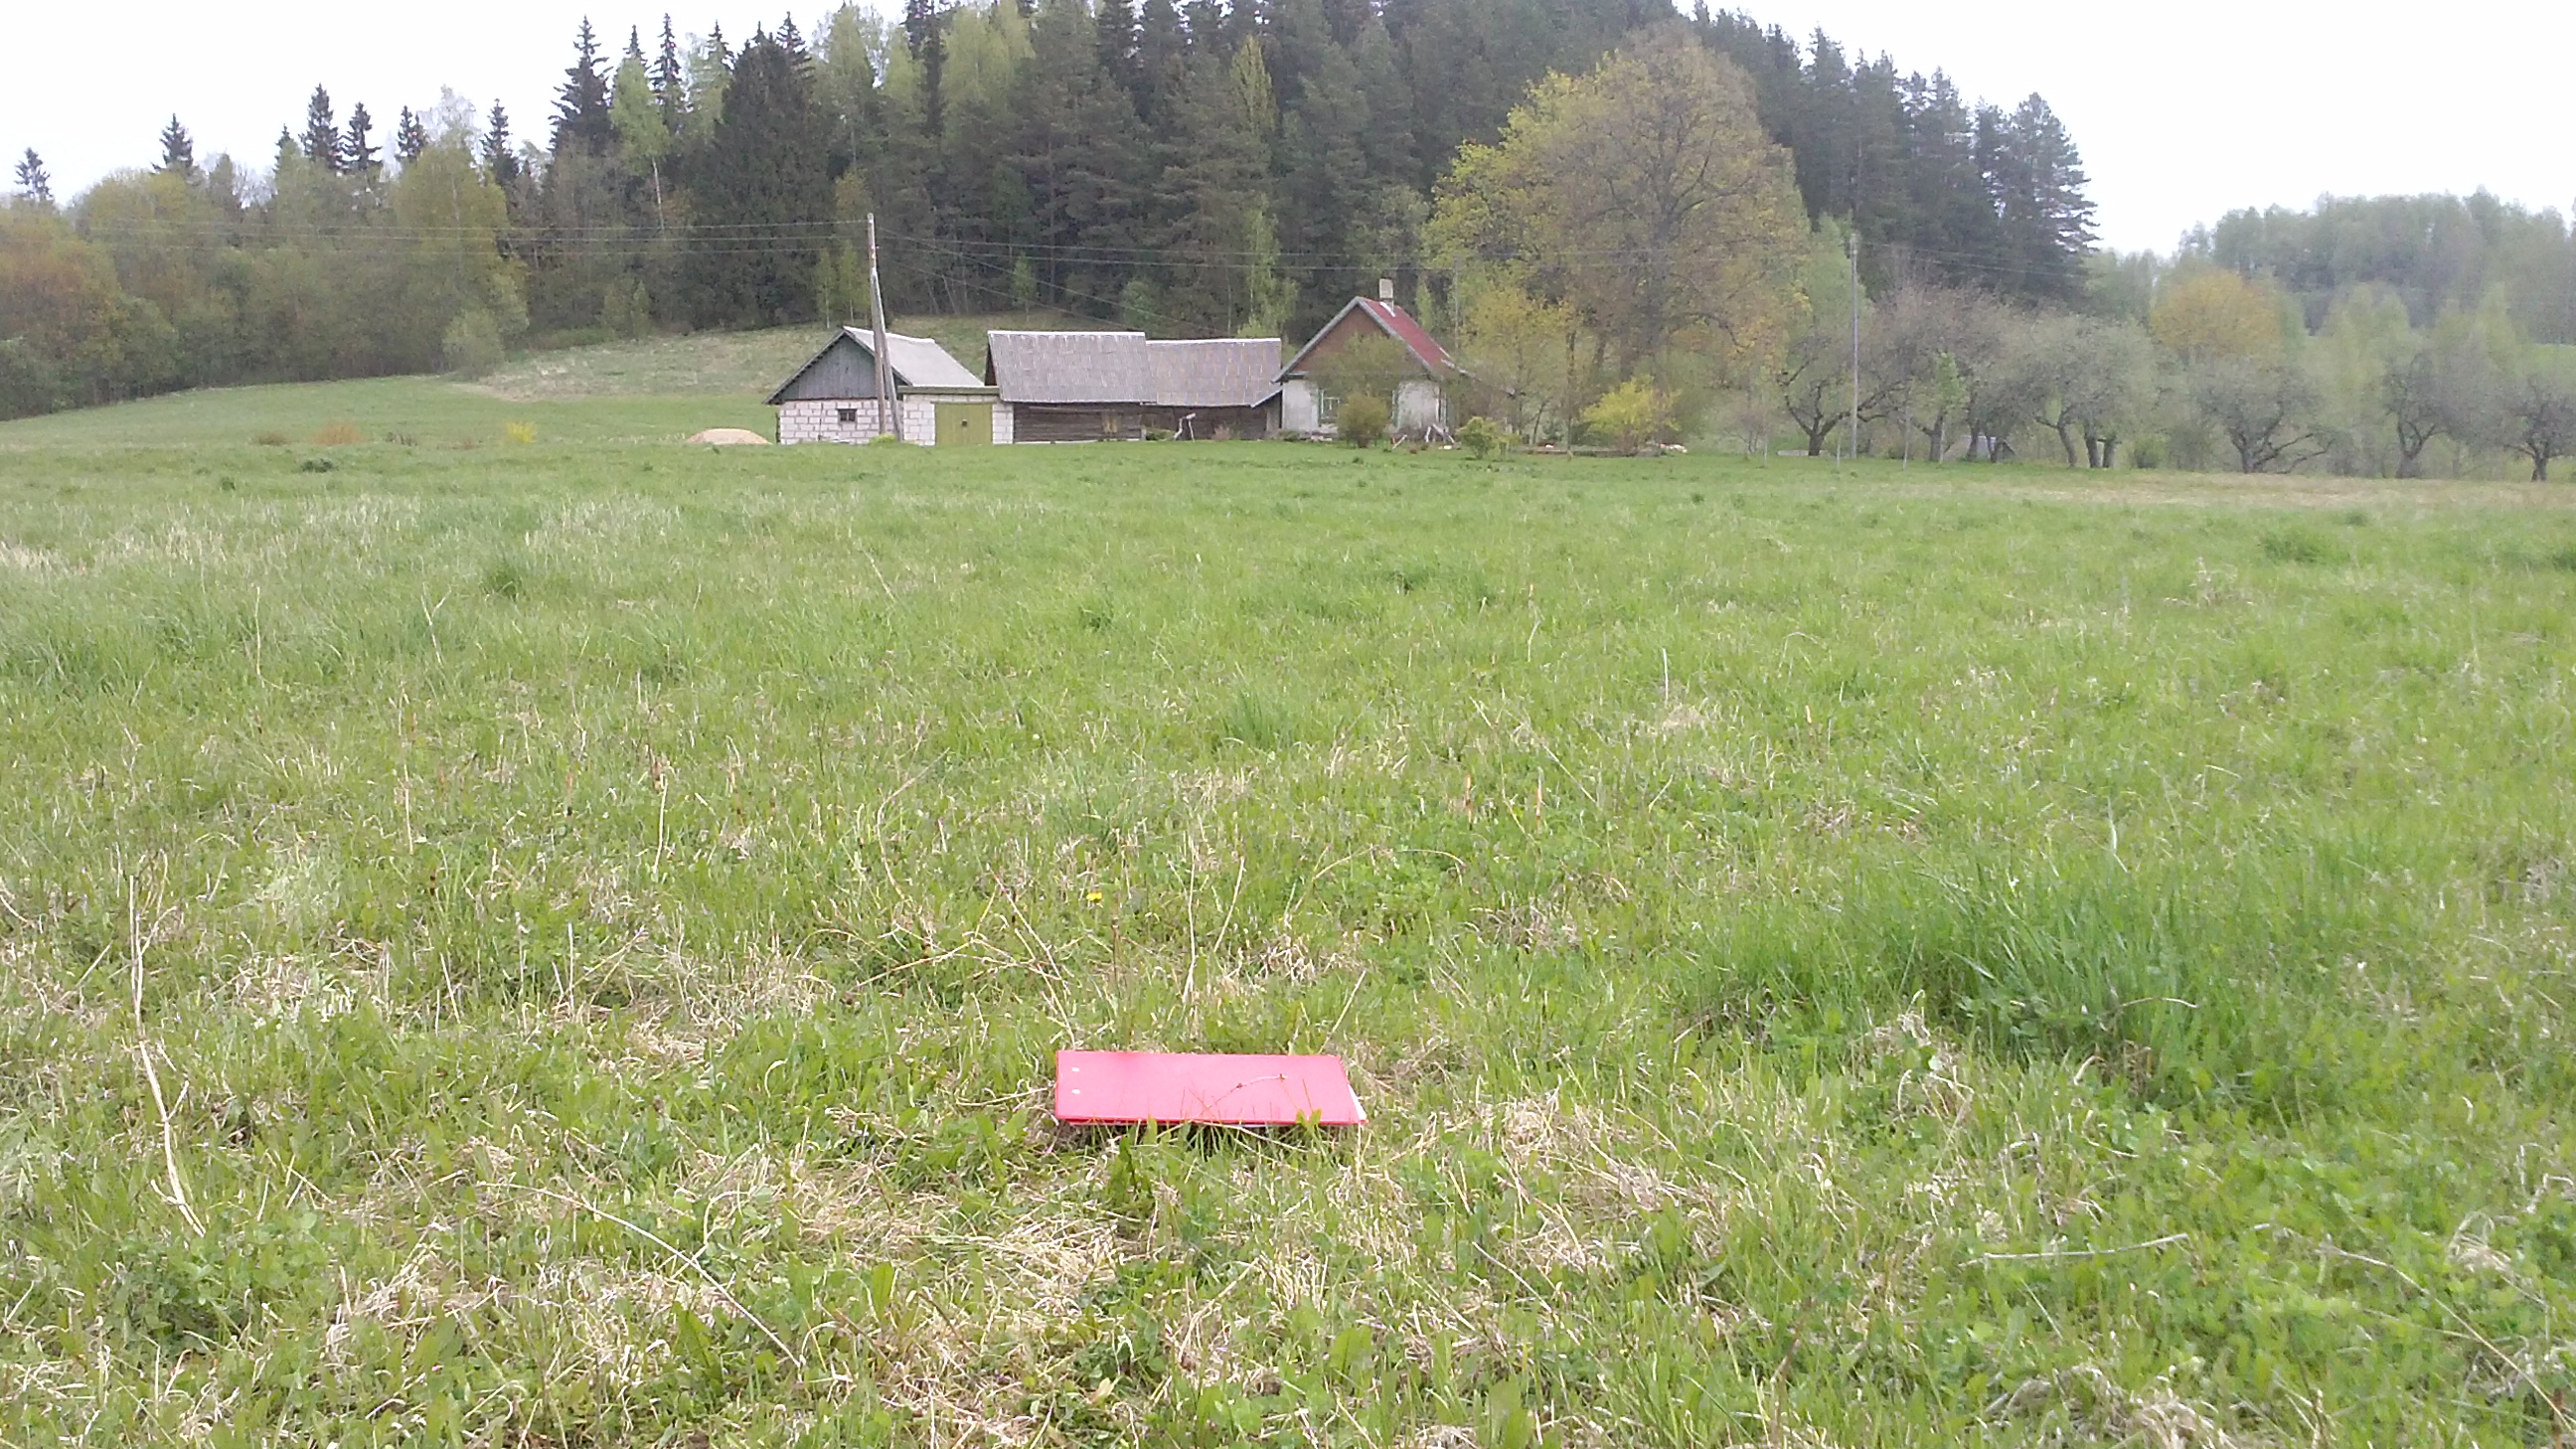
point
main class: Grassland
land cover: Grassland without tree/shrub cover
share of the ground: > 75 %
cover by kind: herbaceous plants 100 %
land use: Agriculture (excluding fallow land and kitchen gardens)
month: May
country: LV
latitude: 55.9579
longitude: 27.1652
